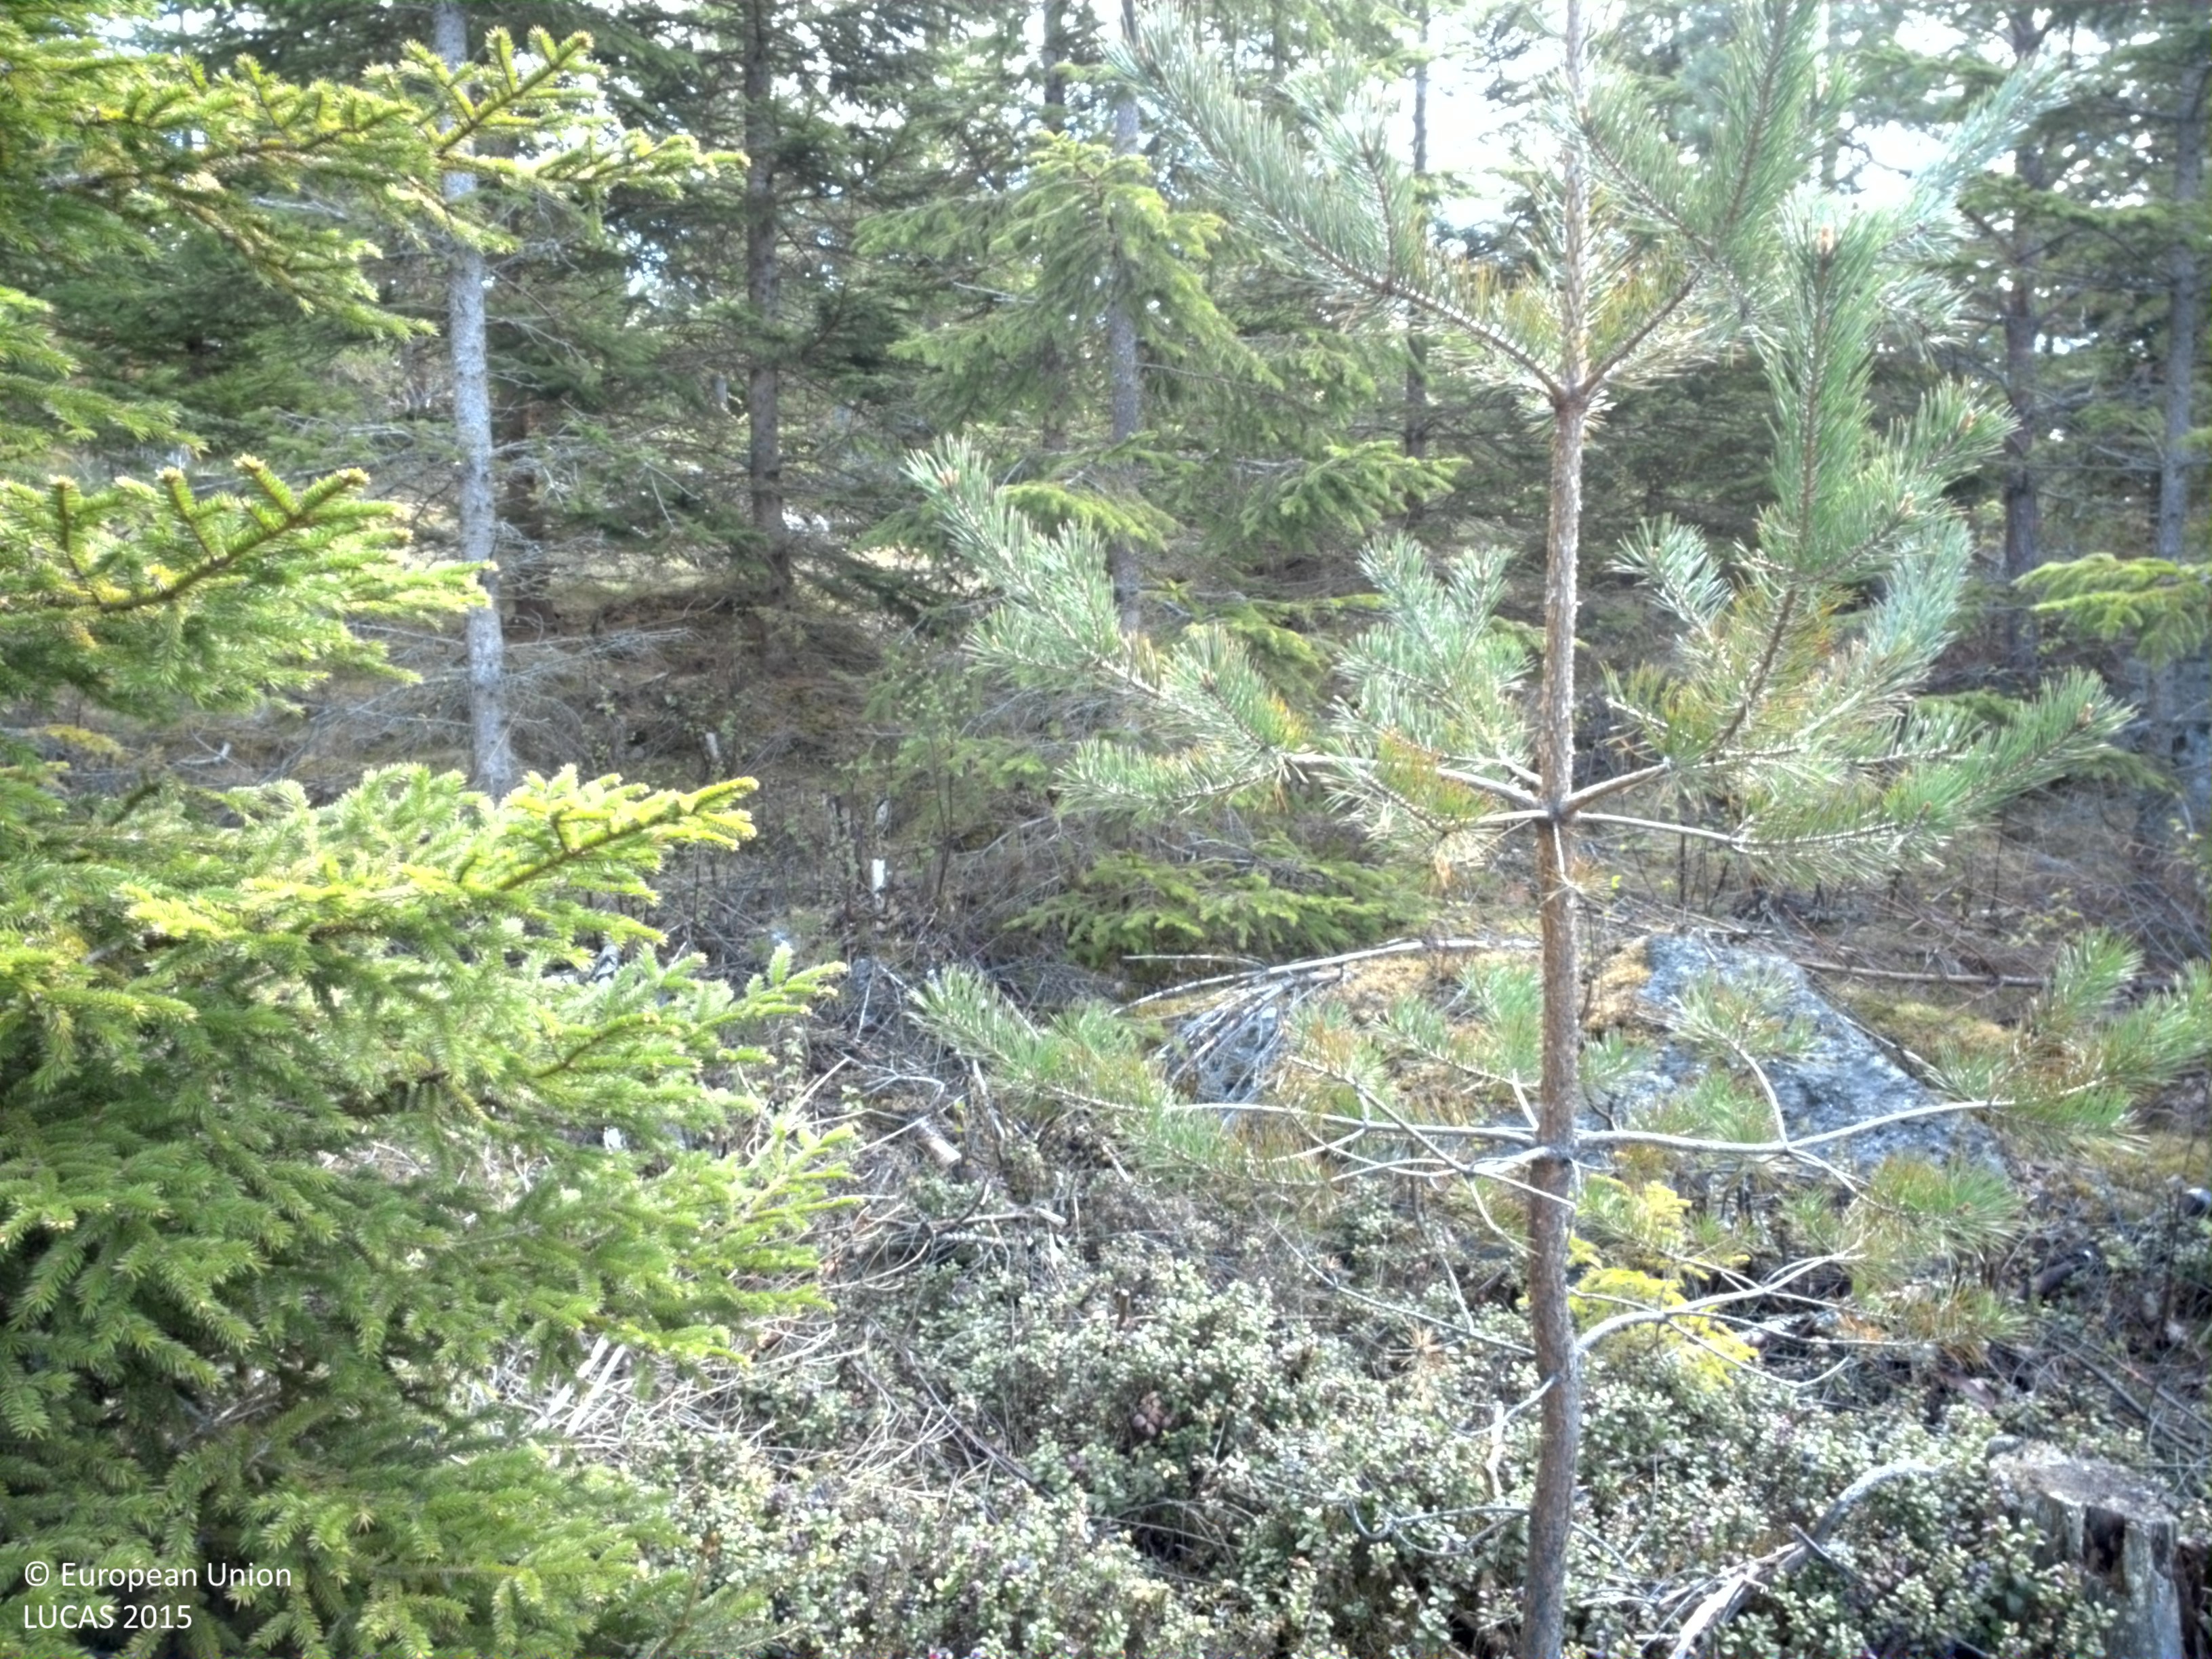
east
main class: Woodland
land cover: Other coniferous woodland
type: boreal forest
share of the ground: > 75 %
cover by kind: coniferous forest trees 75 %, shrubs 10 %, lichens and mosses 10 %, consolidated bare surface 5 %
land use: Forestry
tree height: > 5 m
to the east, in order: Other coniferous woodland; Other mixed woodland; Inland marshes; Pine dominated coniferous woodland; Peatbogs; Pine dominated coniferous woodland
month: May
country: SE
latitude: 59.2301
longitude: 14.3553
